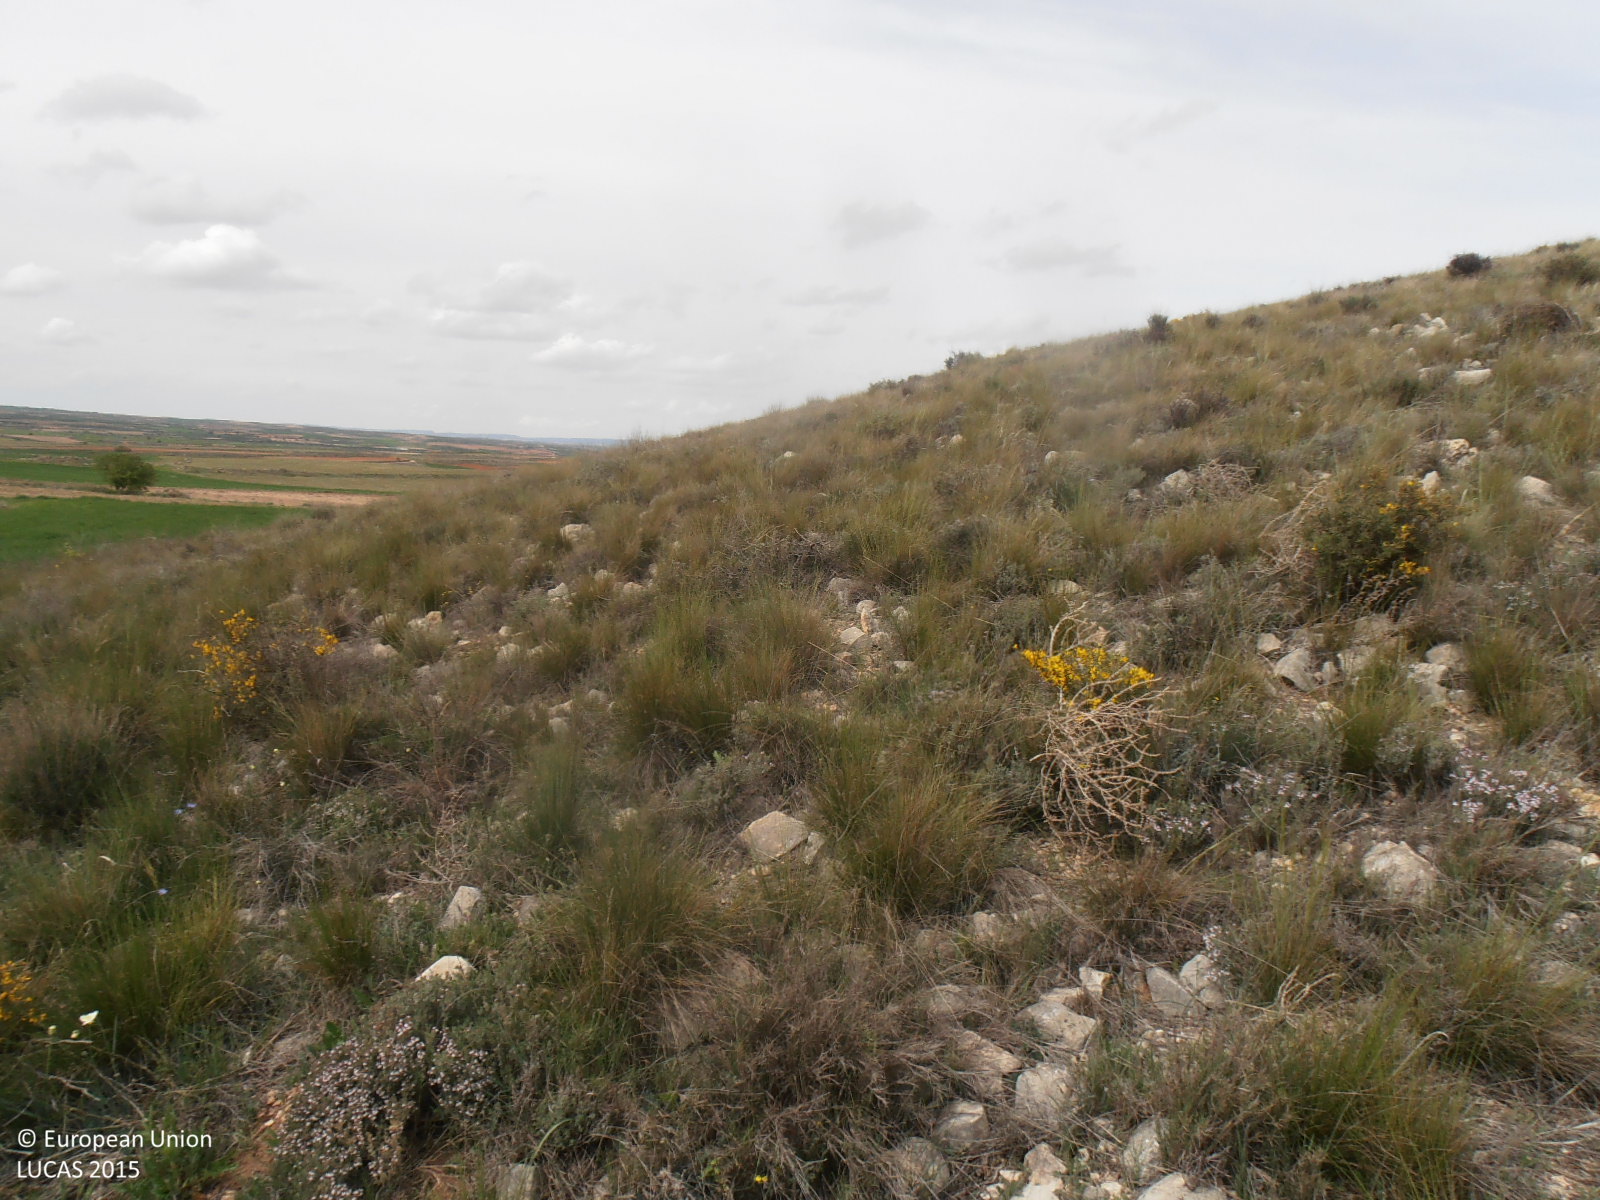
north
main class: Shrubland
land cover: Shrubland without tree cover
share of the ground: > 75 %
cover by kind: shrubs 60 %, consolidated bare surface 30 %, herbaceous plants 10 %
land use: Semi-natural and natural areas not in use
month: April
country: ES
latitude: 41.0948
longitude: -0.9343
